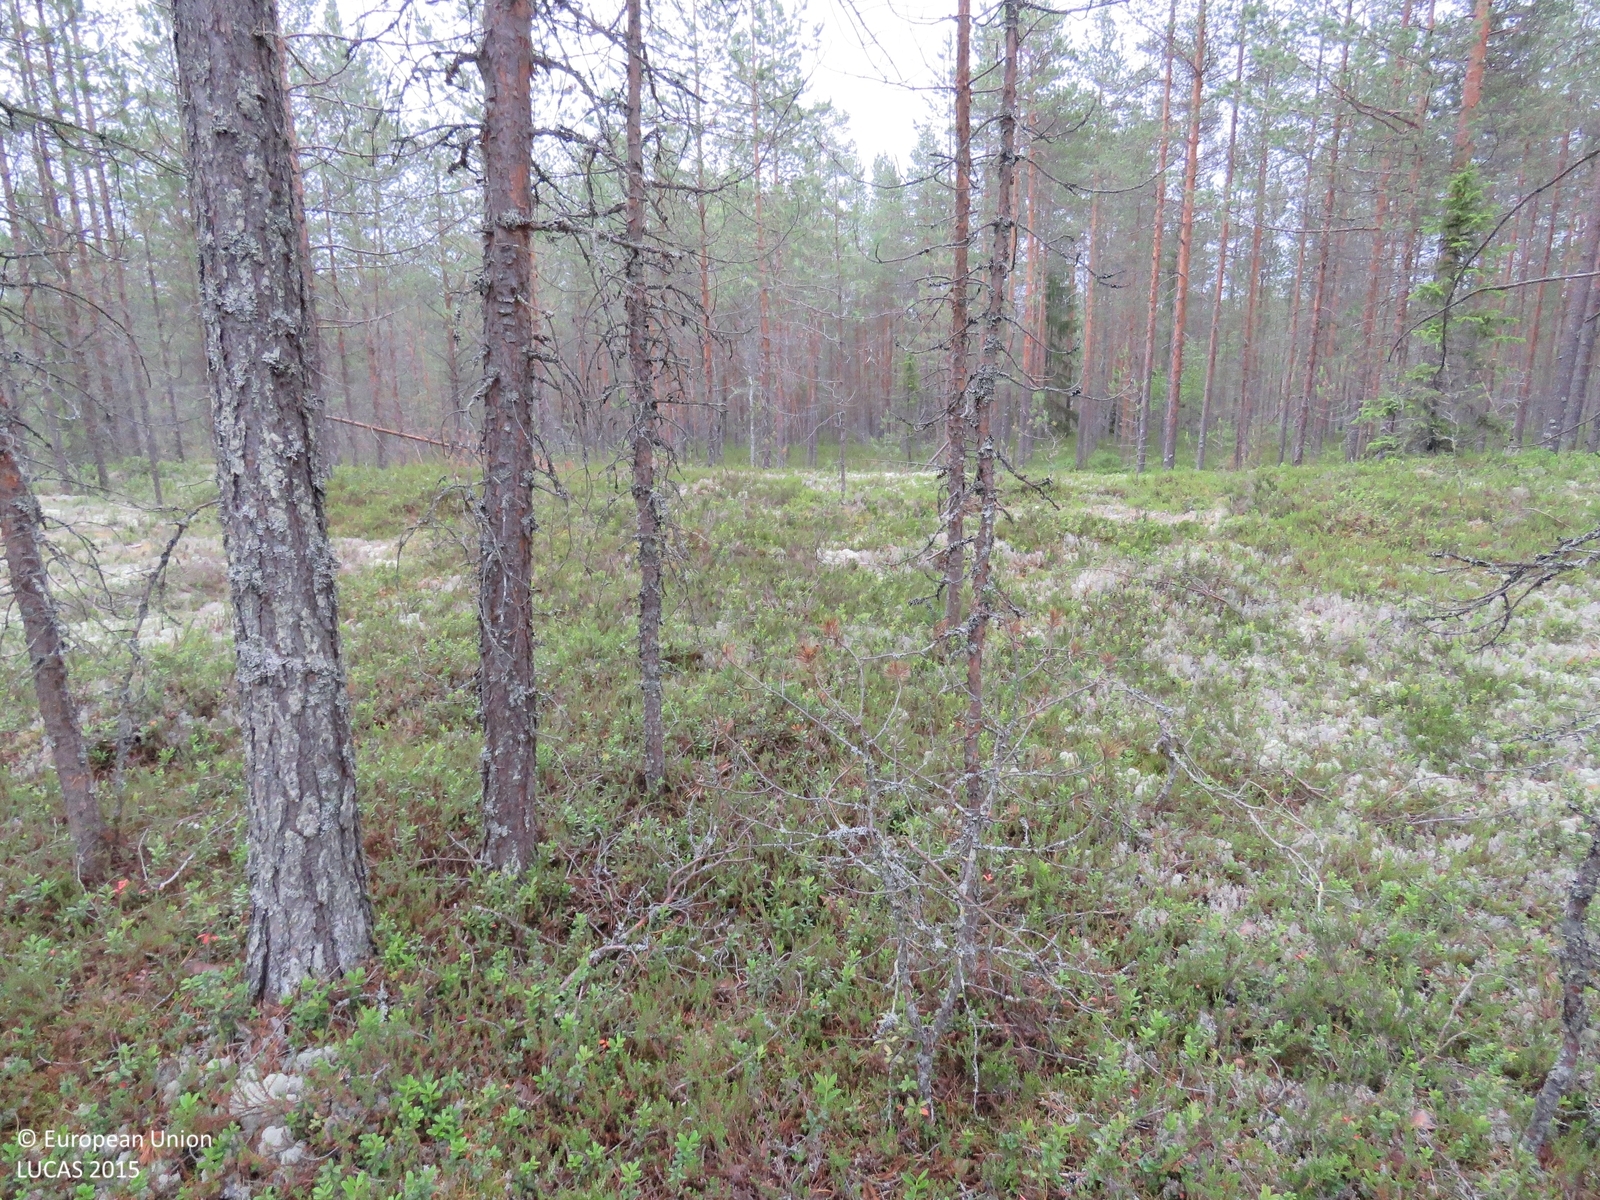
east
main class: Woodland
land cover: Pine dominated coniferous woodland
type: boreal forest
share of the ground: > 75 %
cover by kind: coniferous forest trees 80 %, shrubs 10 %, lichens and mosses 10 %
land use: Forestry
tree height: > 5 m
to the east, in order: Pine dominated coniferous woodland; Ditches and canals; Pine dominated coniferous woodland; Ditches and canals; Pine dominated mixed woodland; Pine dominated coniferous woodland; Ditches and canals; Pine dominated mixed woodland; Ditches and canals; Grassland with sparse tree/shrub cover
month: July
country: FI
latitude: 64.3241
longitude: 26.3086
